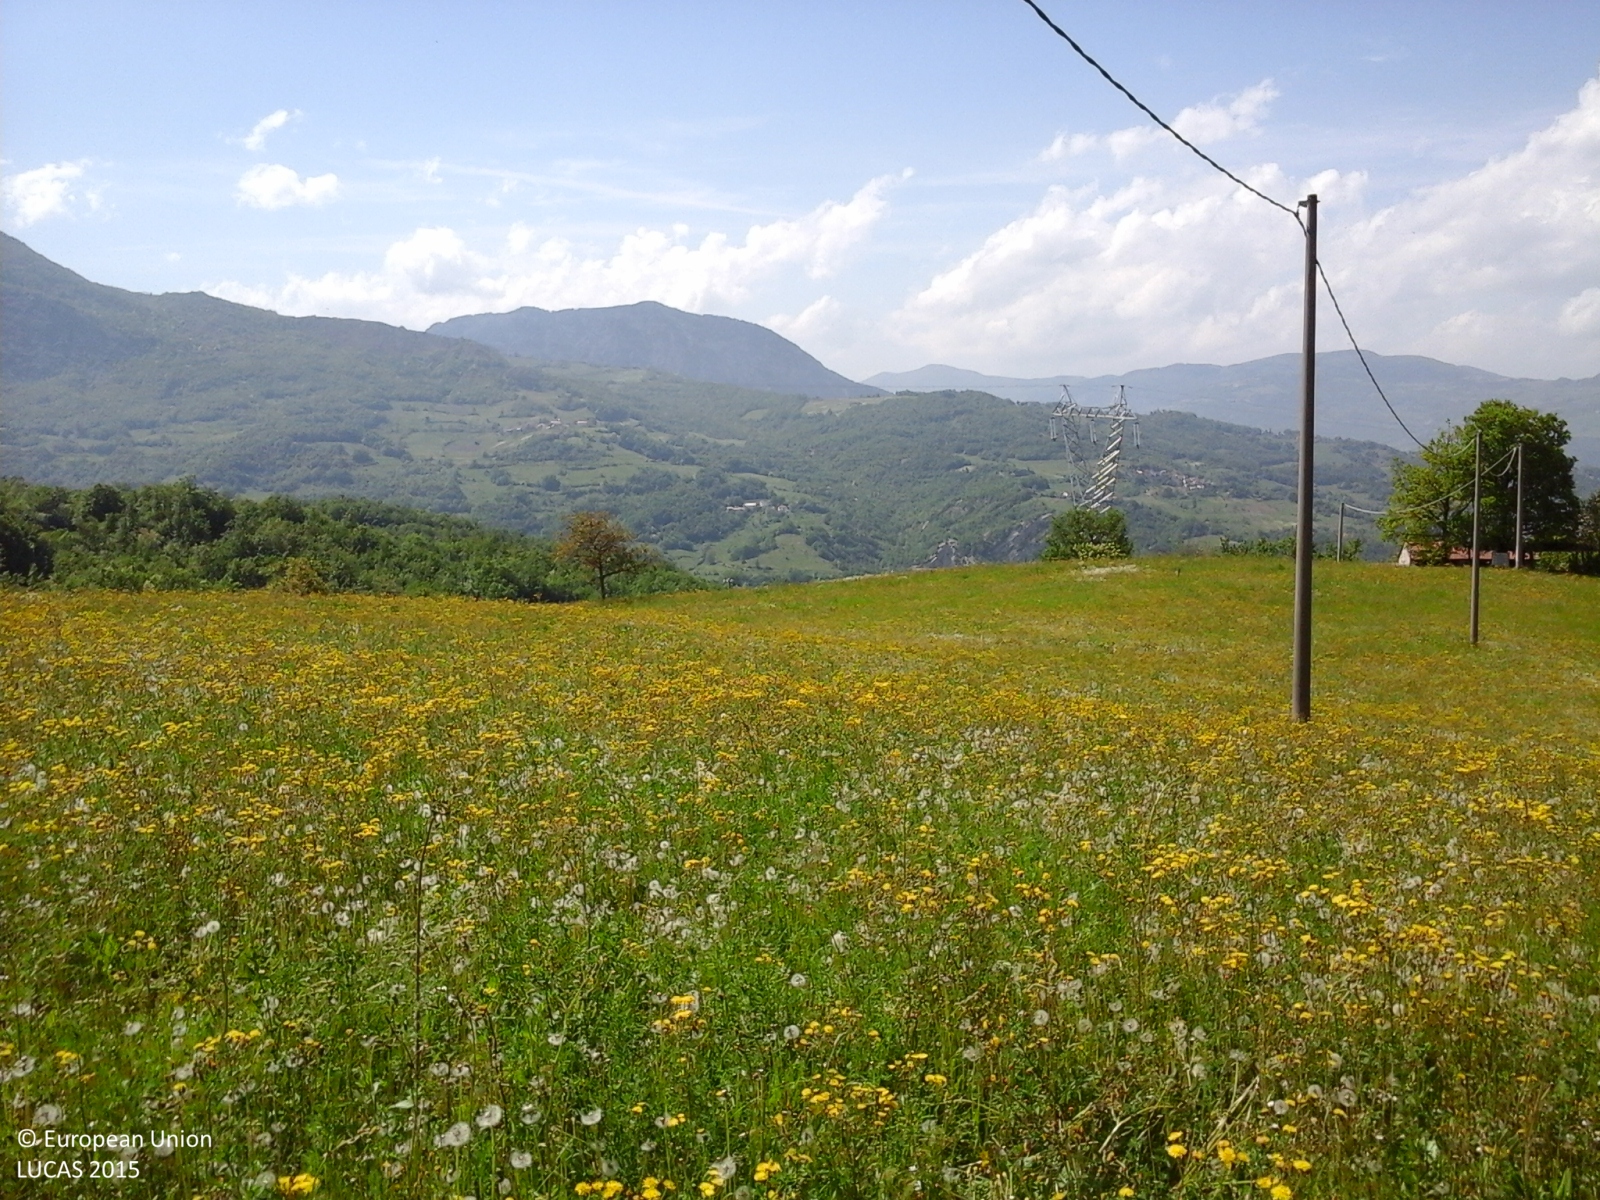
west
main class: Grassland
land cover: Grassland without tree/shrub cover
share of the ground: > 75 %
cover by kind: herbaceous plants 100 %
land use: Agriculture (excluding fallow land and kitchen gardens)
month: May
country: IT
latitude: 44.7823
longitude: 9.5334
